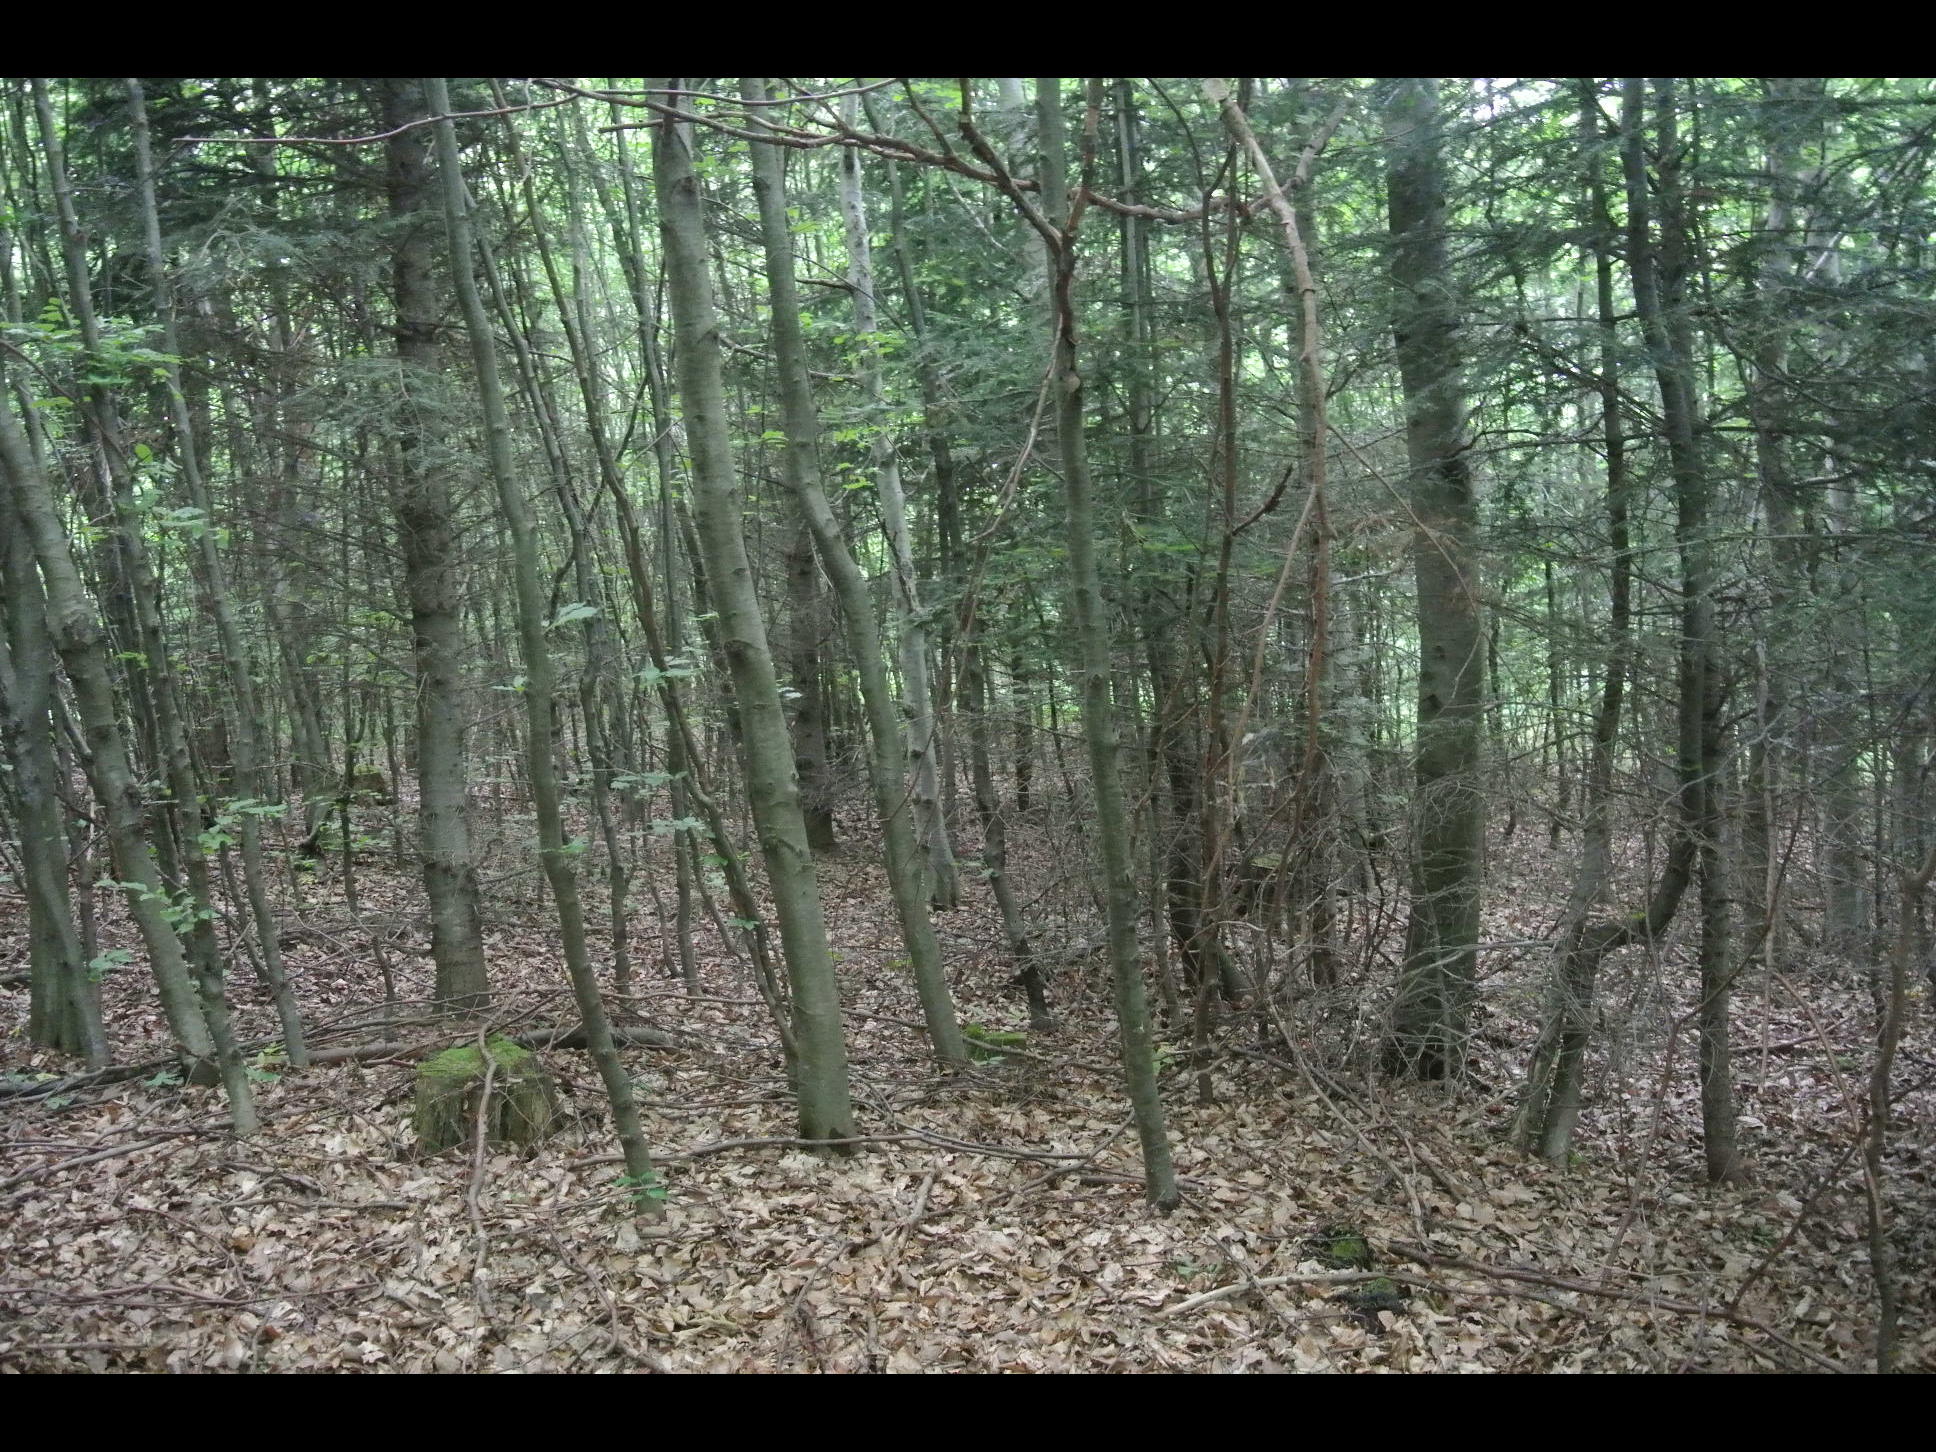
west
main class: Woodland
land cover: Spruce dominated mixed woodland
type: alpine coniferous forest
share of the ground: > 75 %
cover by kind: broadleaved forest trees 75 %, coniferous forest trees 25 %
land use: Forestry
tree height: > 5 m
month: June
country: AT
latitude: 48.0512
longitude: 16.1618
